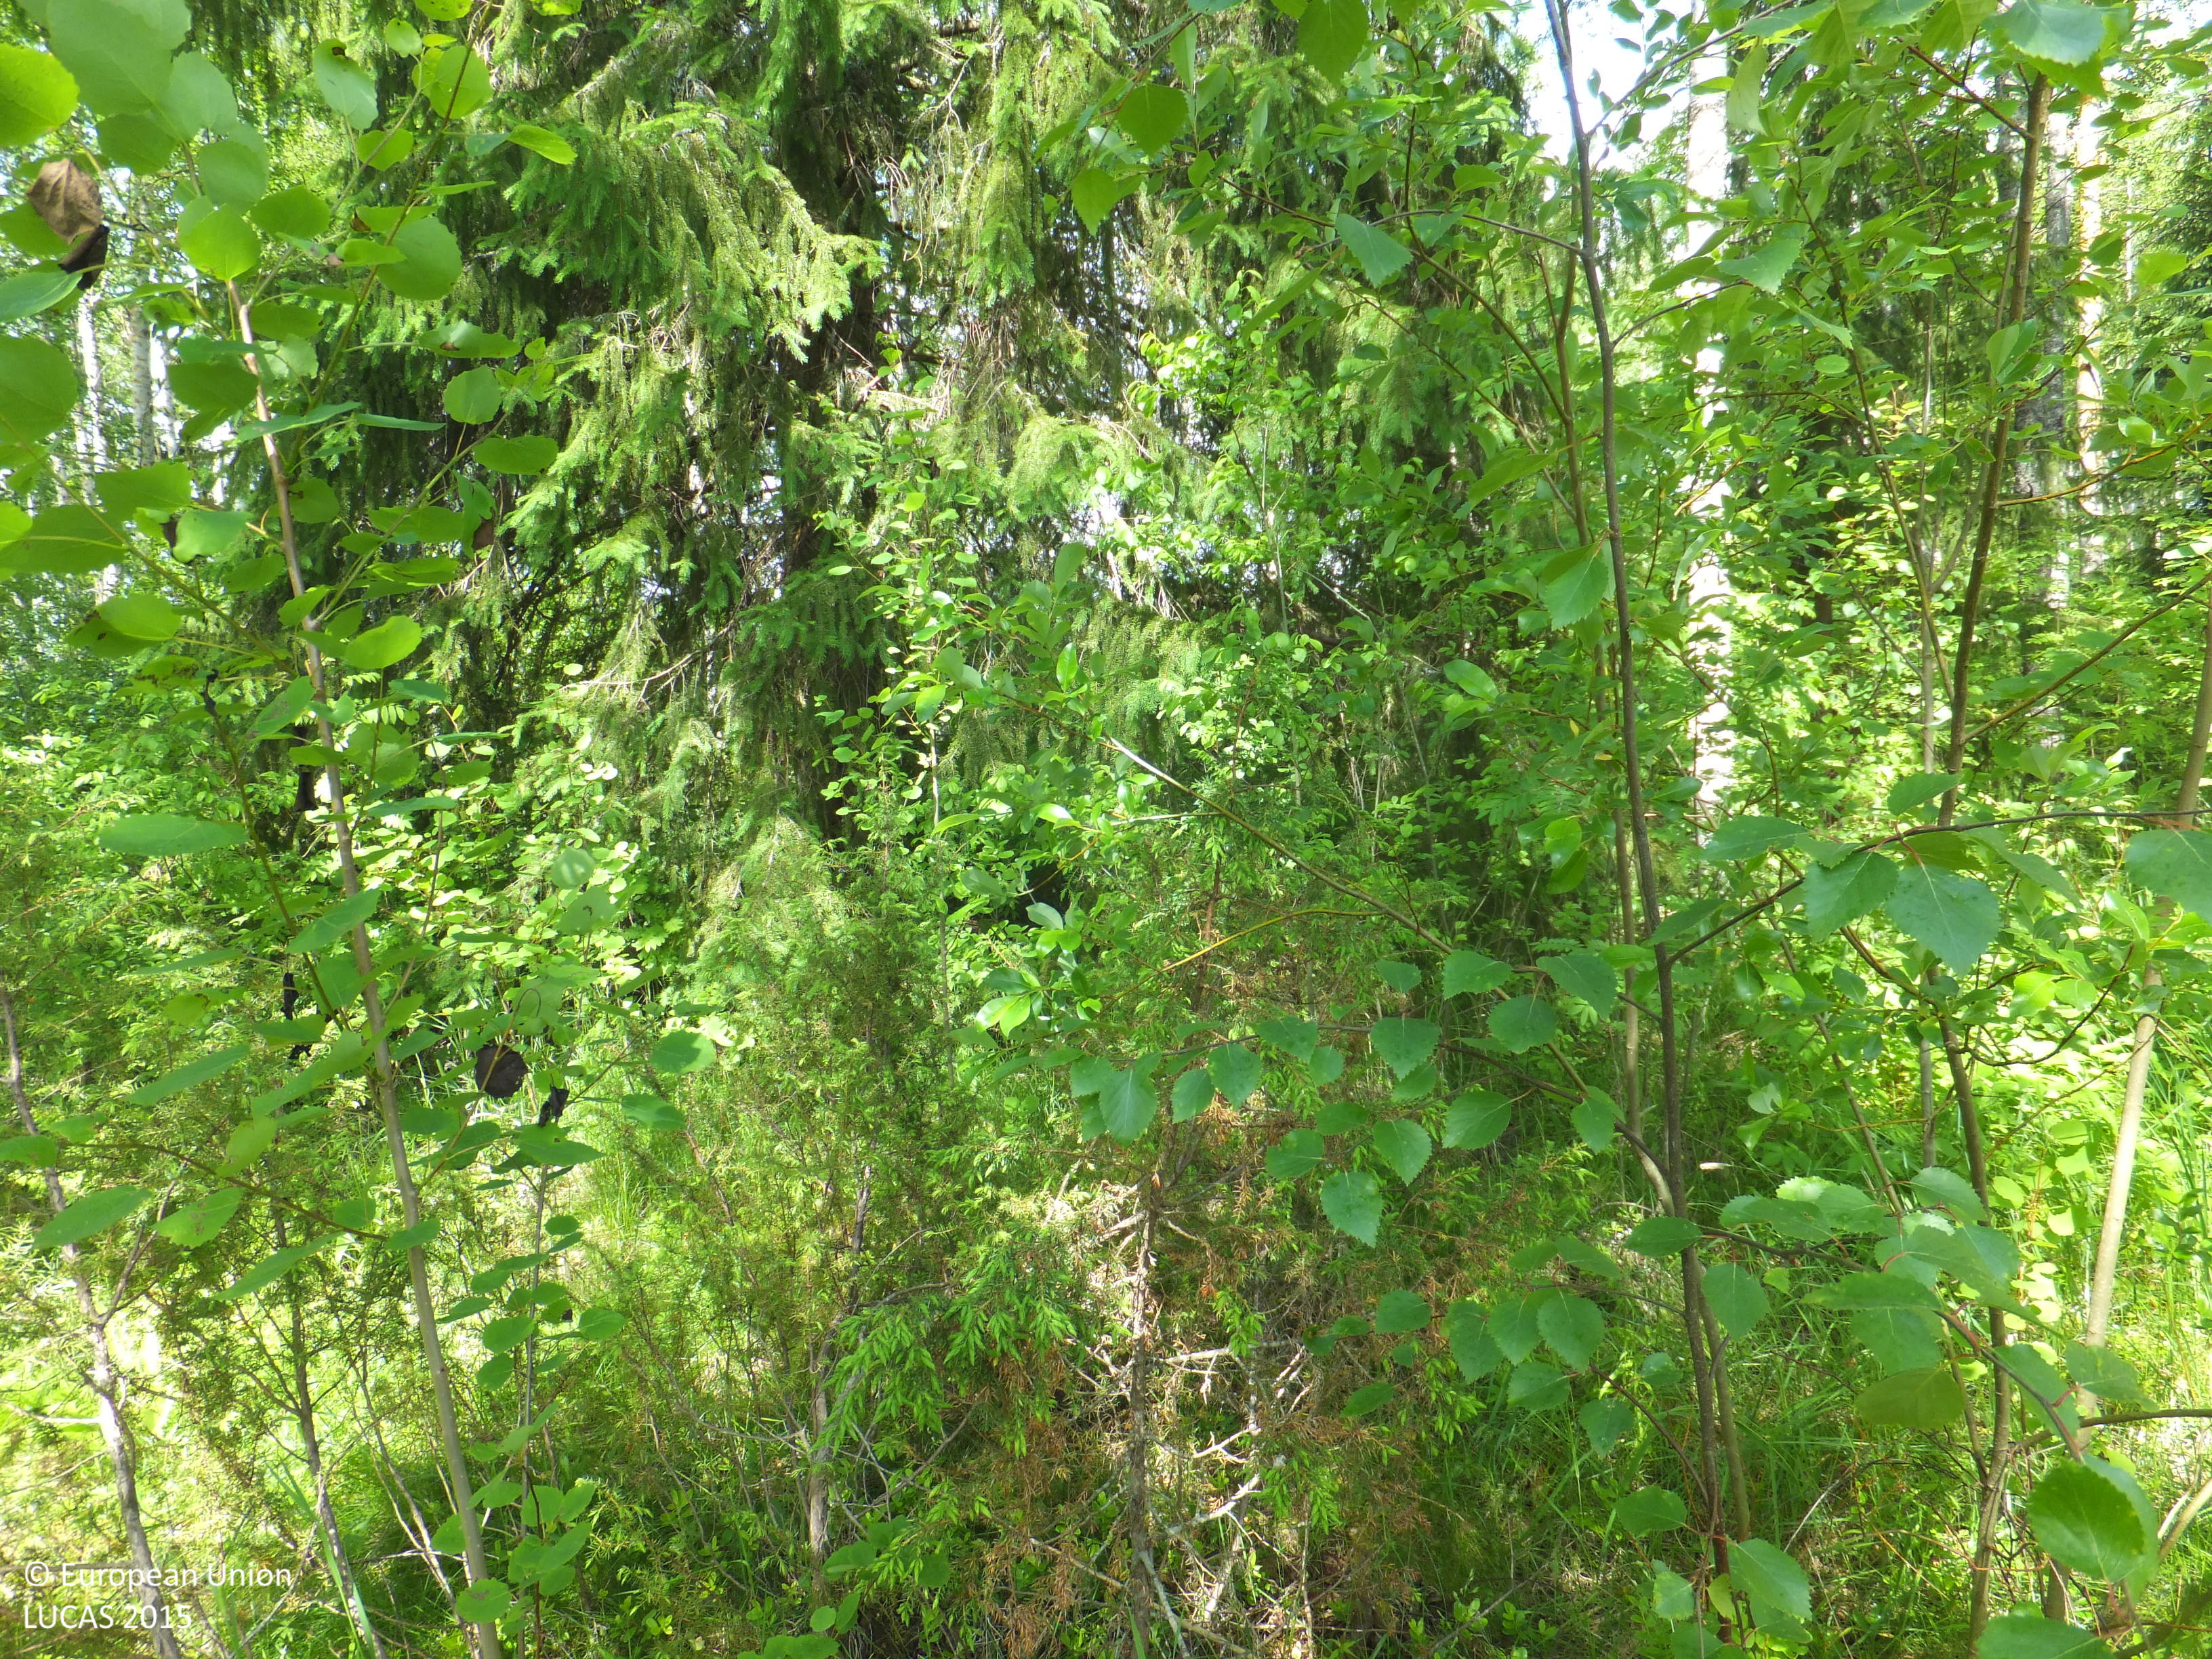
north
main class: Woodland
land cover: Spruce dominated mixed woodland
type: boreal forest
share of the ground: 50 - 75 %
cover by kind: broadleaved forest trees 40 %, herbaceous plants 25 %, coniferous forest trees 20 %, shrubs 15 %
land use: Residential
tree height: > 5 m
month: June
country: FI
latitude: 63.2096
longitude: 23.9329
